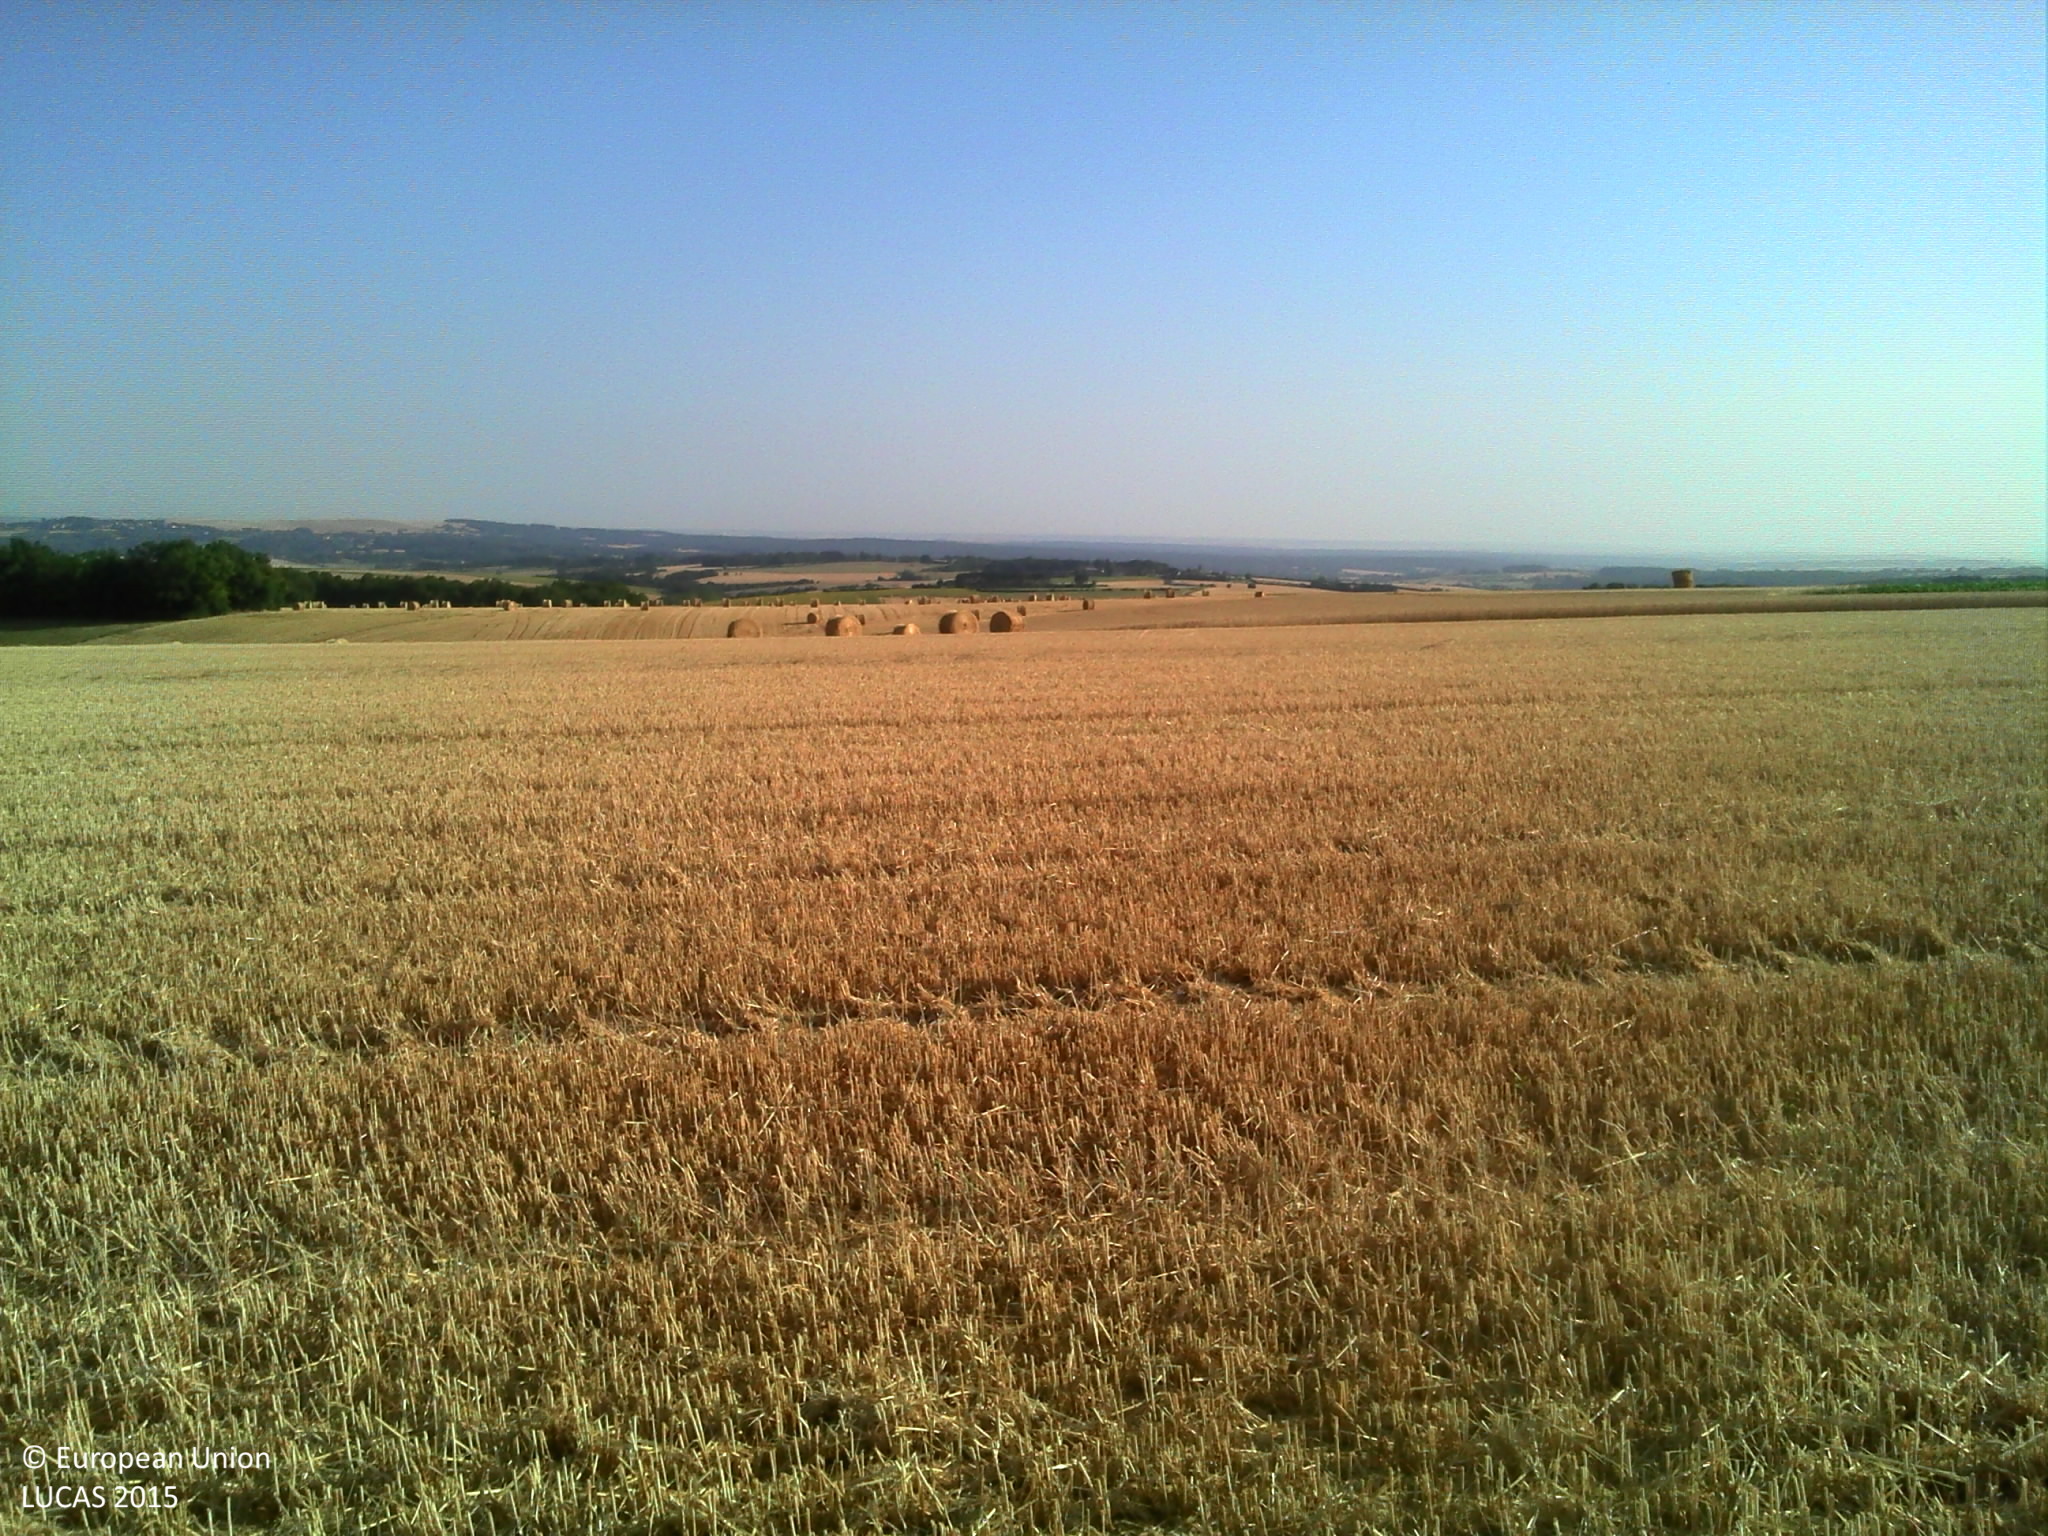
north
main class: Cropland
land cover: Common wheat
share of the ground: > 75 %
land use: Agriculture (excluding fallow land and kitchen gardens)
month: July
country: FR
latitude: 47.6859
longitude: 3.4544
